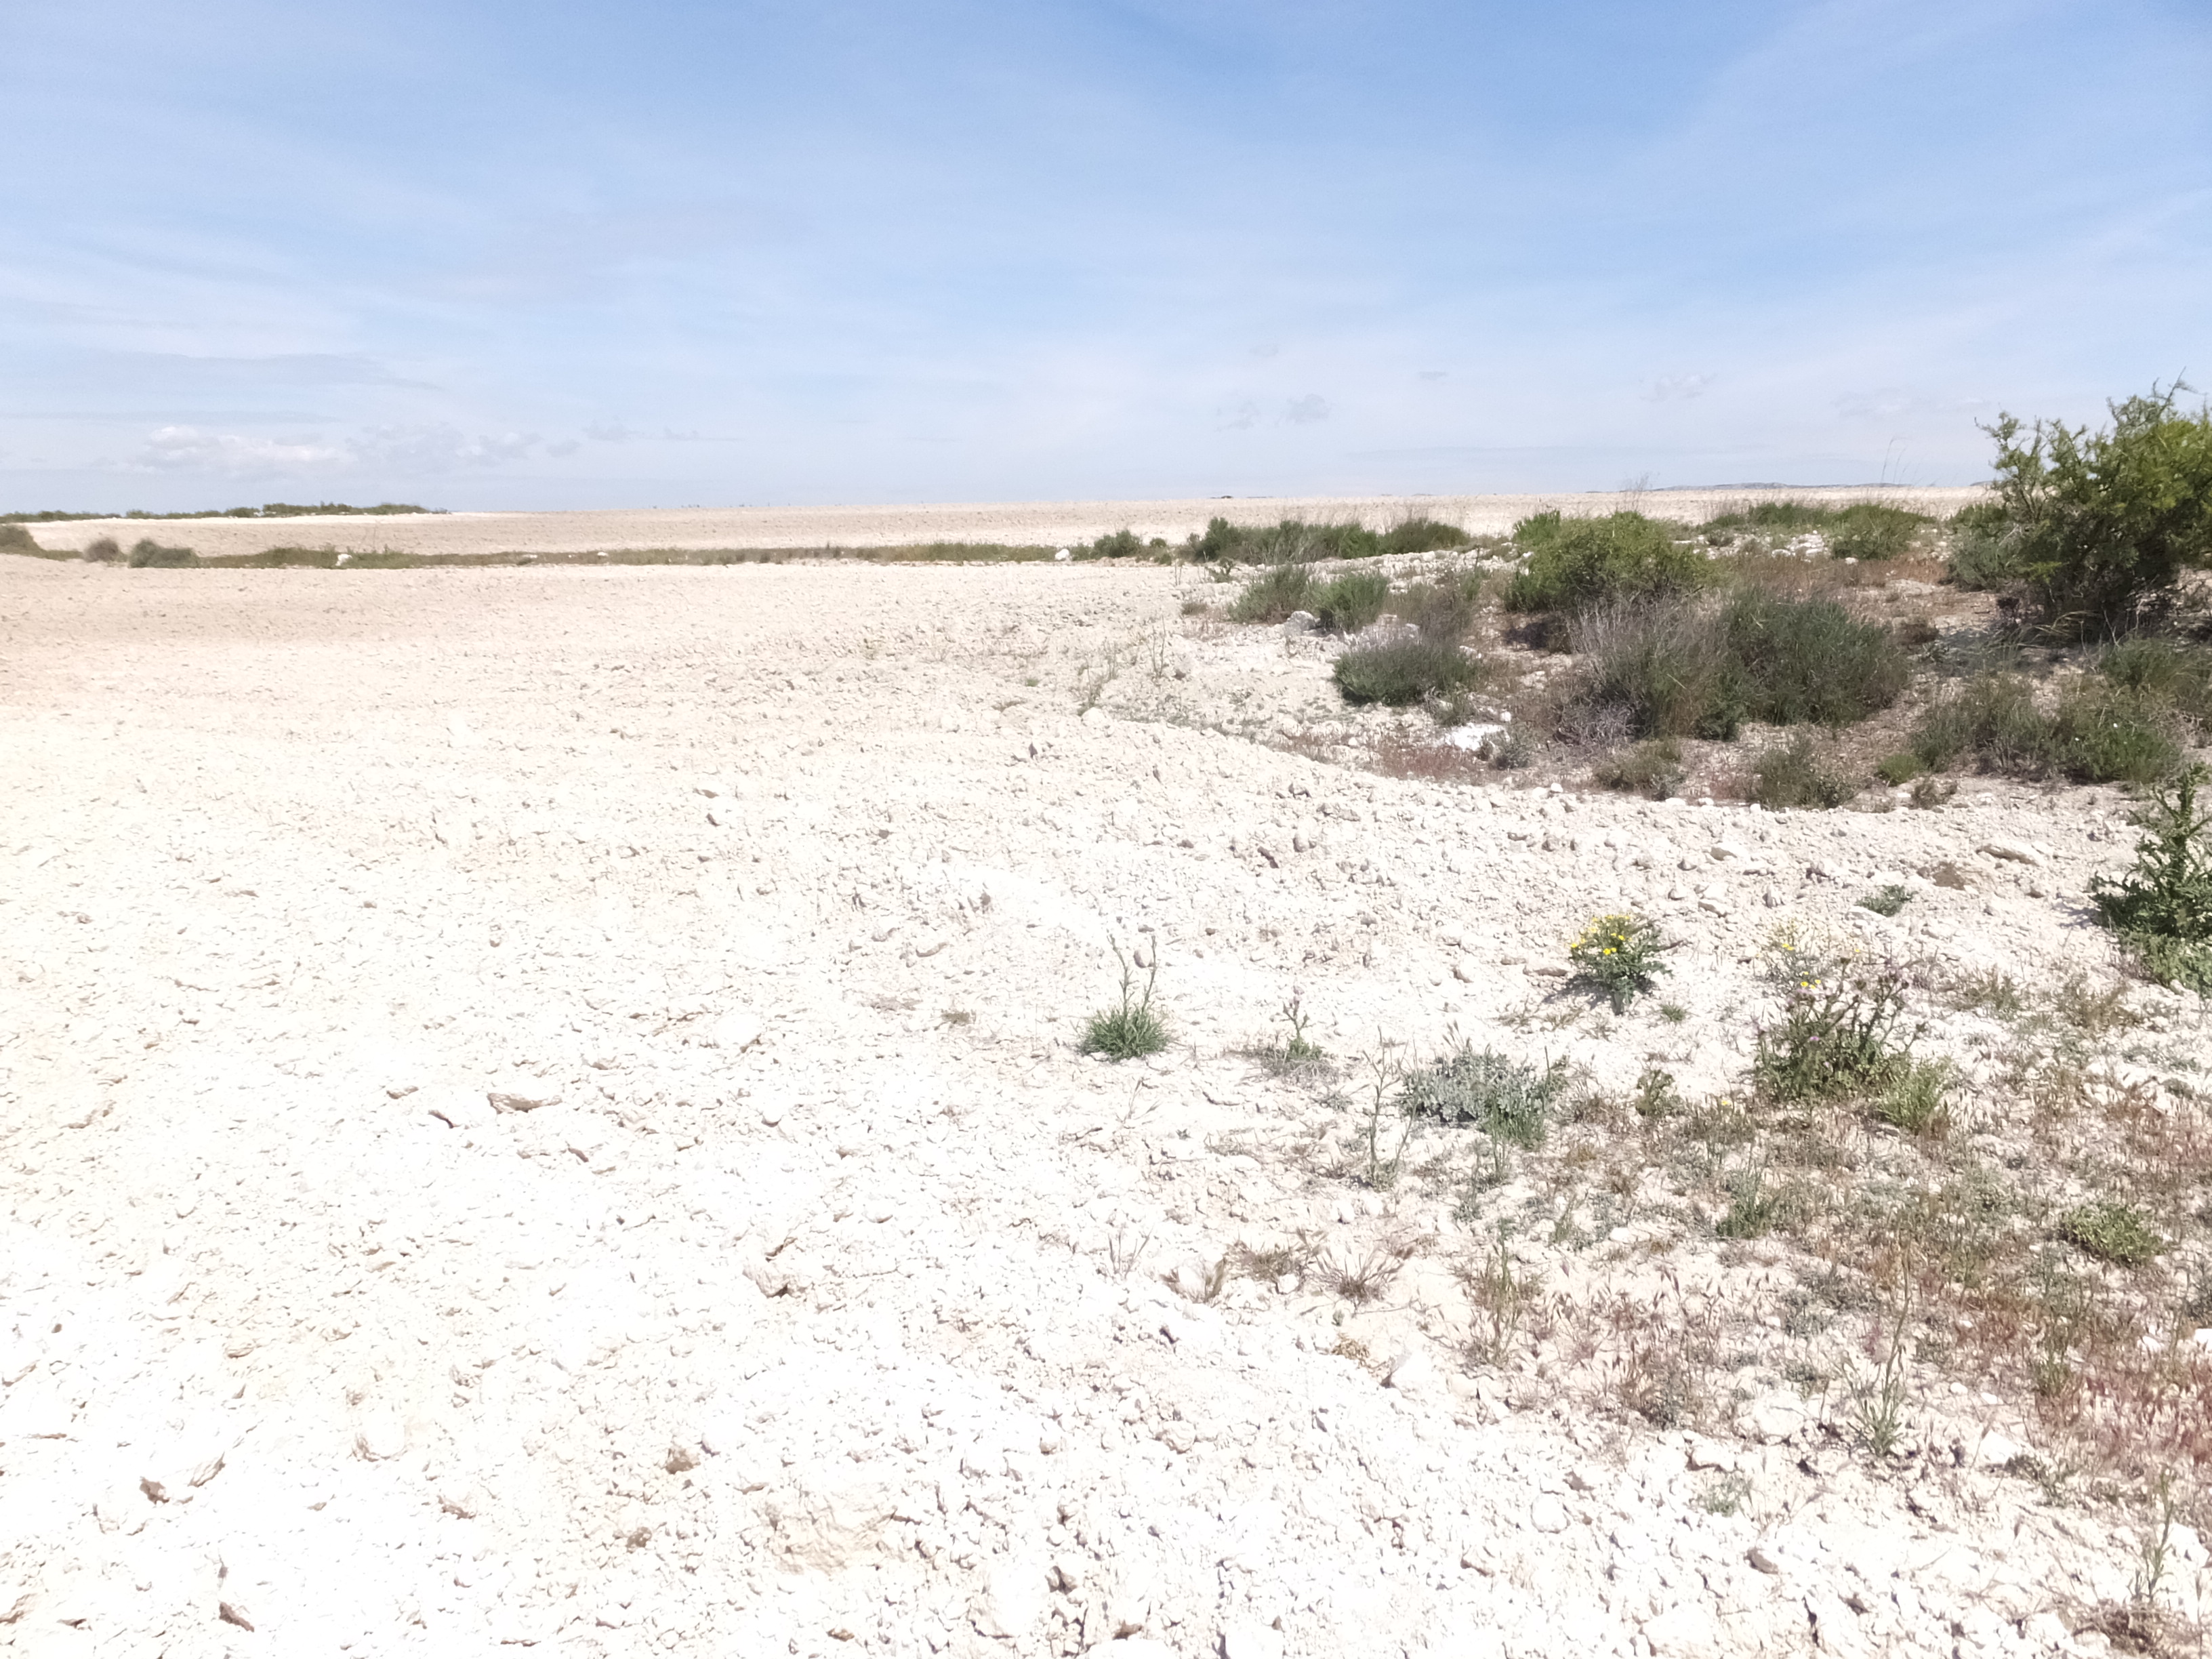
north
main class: Shrubland
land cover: Shrubland without tree cover
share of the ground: > 75 %
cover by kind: shrubs 50 %, herbaceous plants 25 %, consolidated bare surface 25 %
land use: Abandoned areas
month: April
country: ES
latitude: 41.5105
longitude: -0.2844
